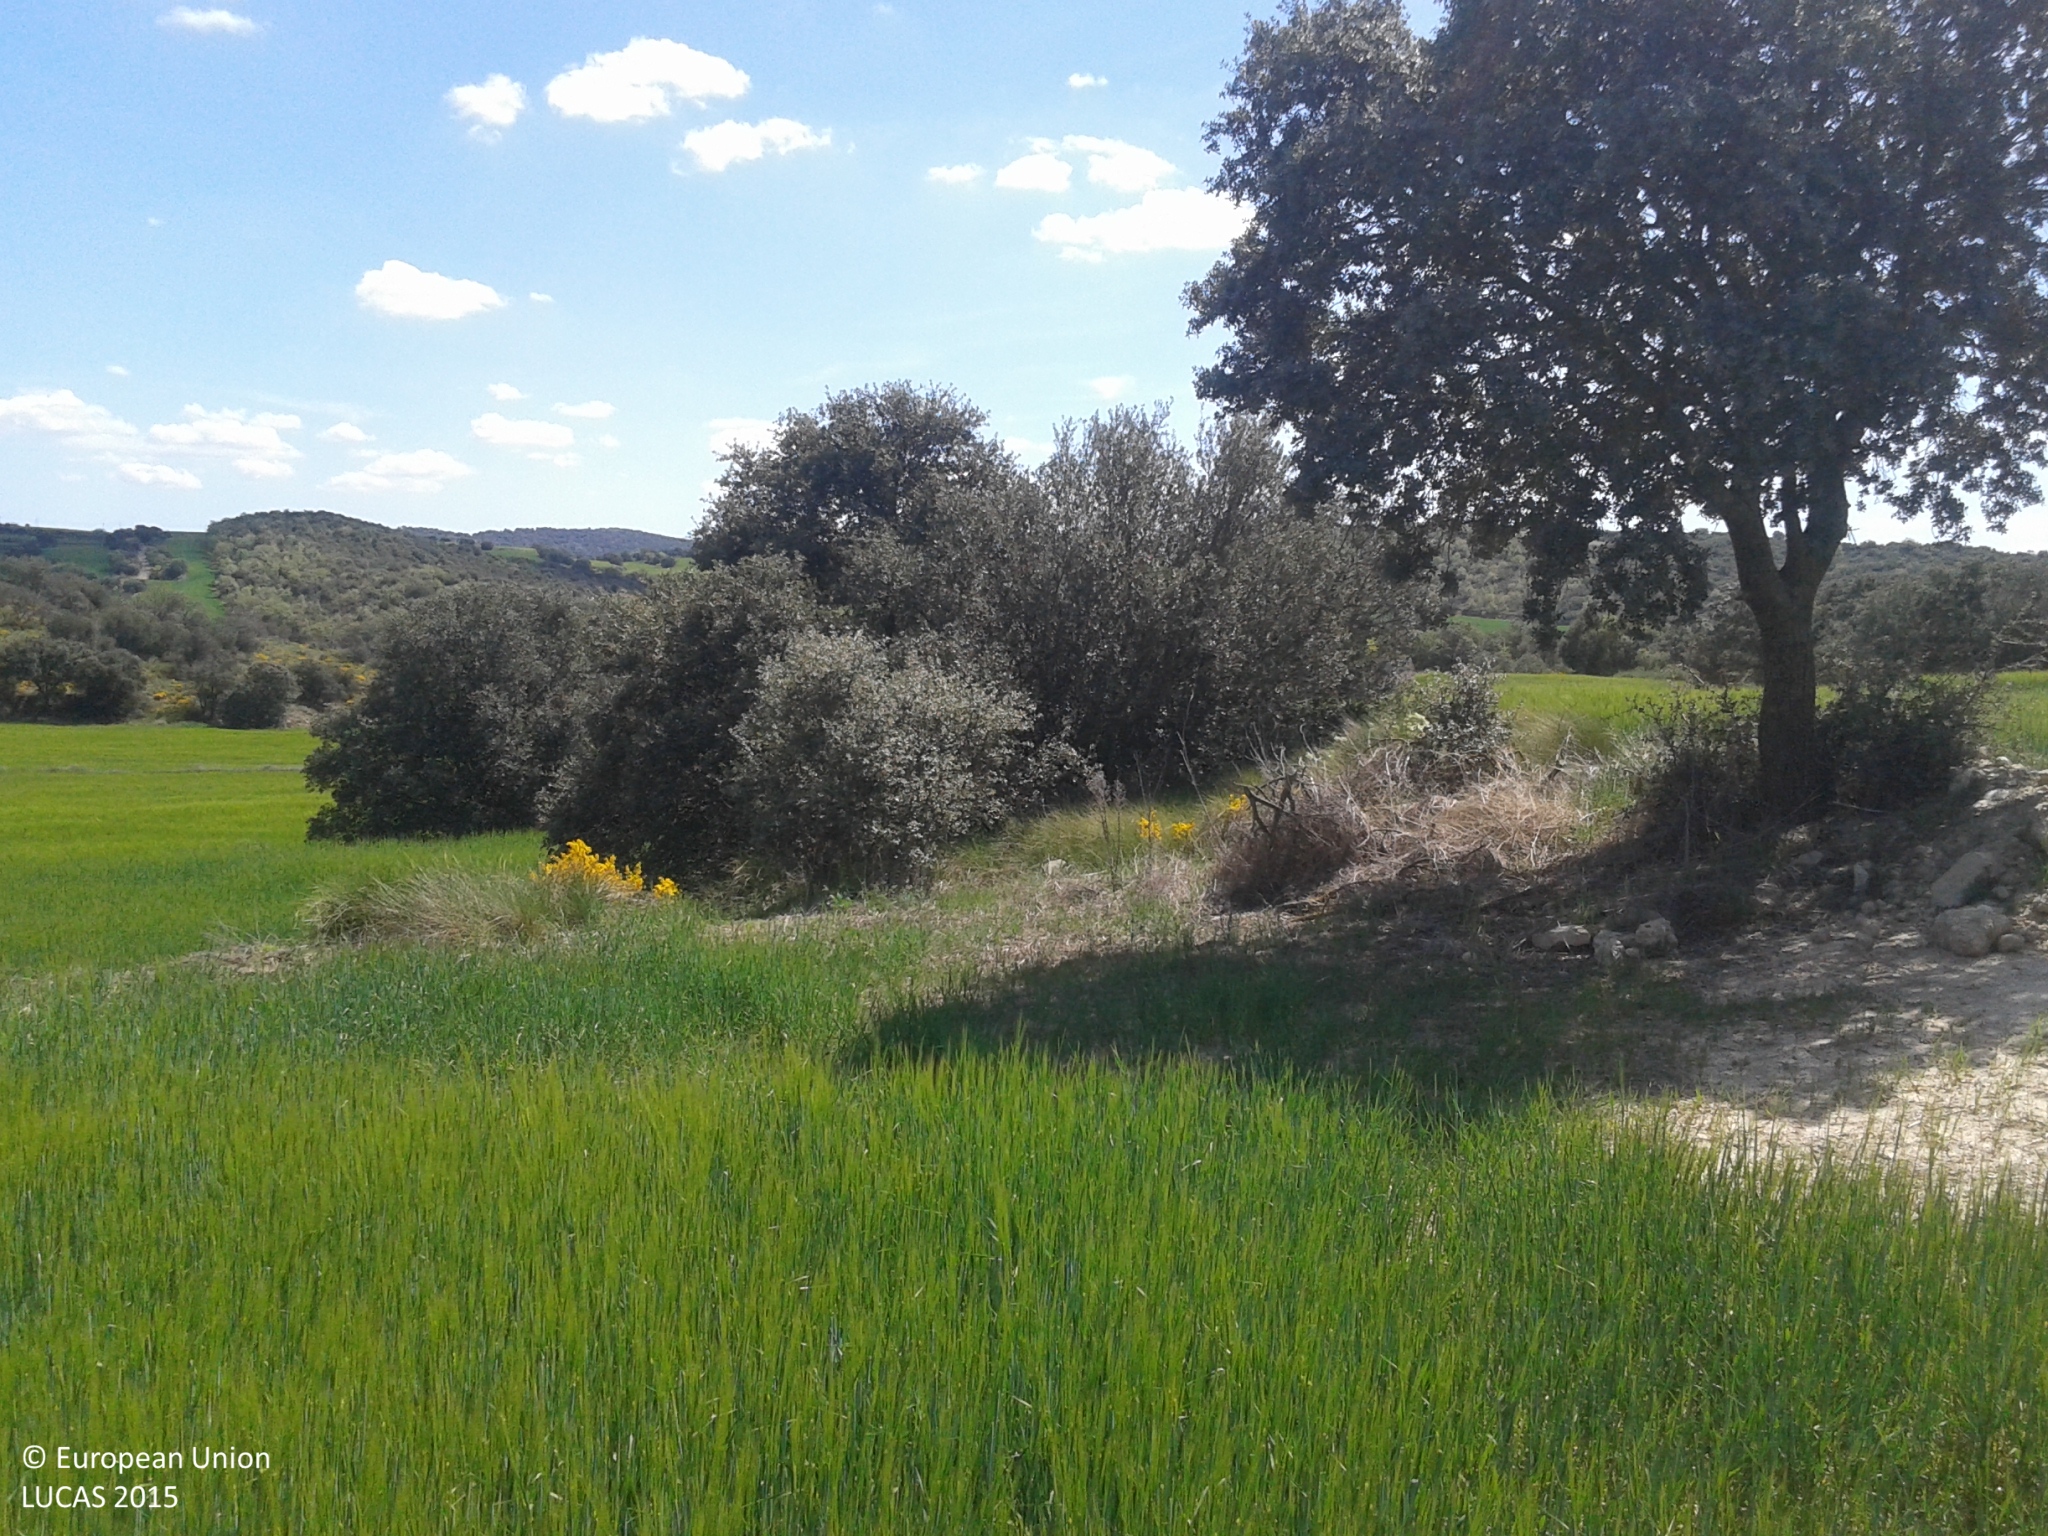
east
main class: Cropland
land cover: Barley
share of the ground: > 75 %
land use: Agriculture (excluding fallow land and kitchen gardens)
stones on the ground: 10 - 25 %
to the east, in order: Barley; Grass margins; Barley; Grass margins; Groves; Barley; Grass margins; Barley; Grass margins; Barley; Grass margins; Dry stone walls; Barley; Grass margins; Dry stone walls; Groves; Barley; Broadleaved woodland
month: April
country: ES
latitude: 41.8291
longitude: 1.1384
